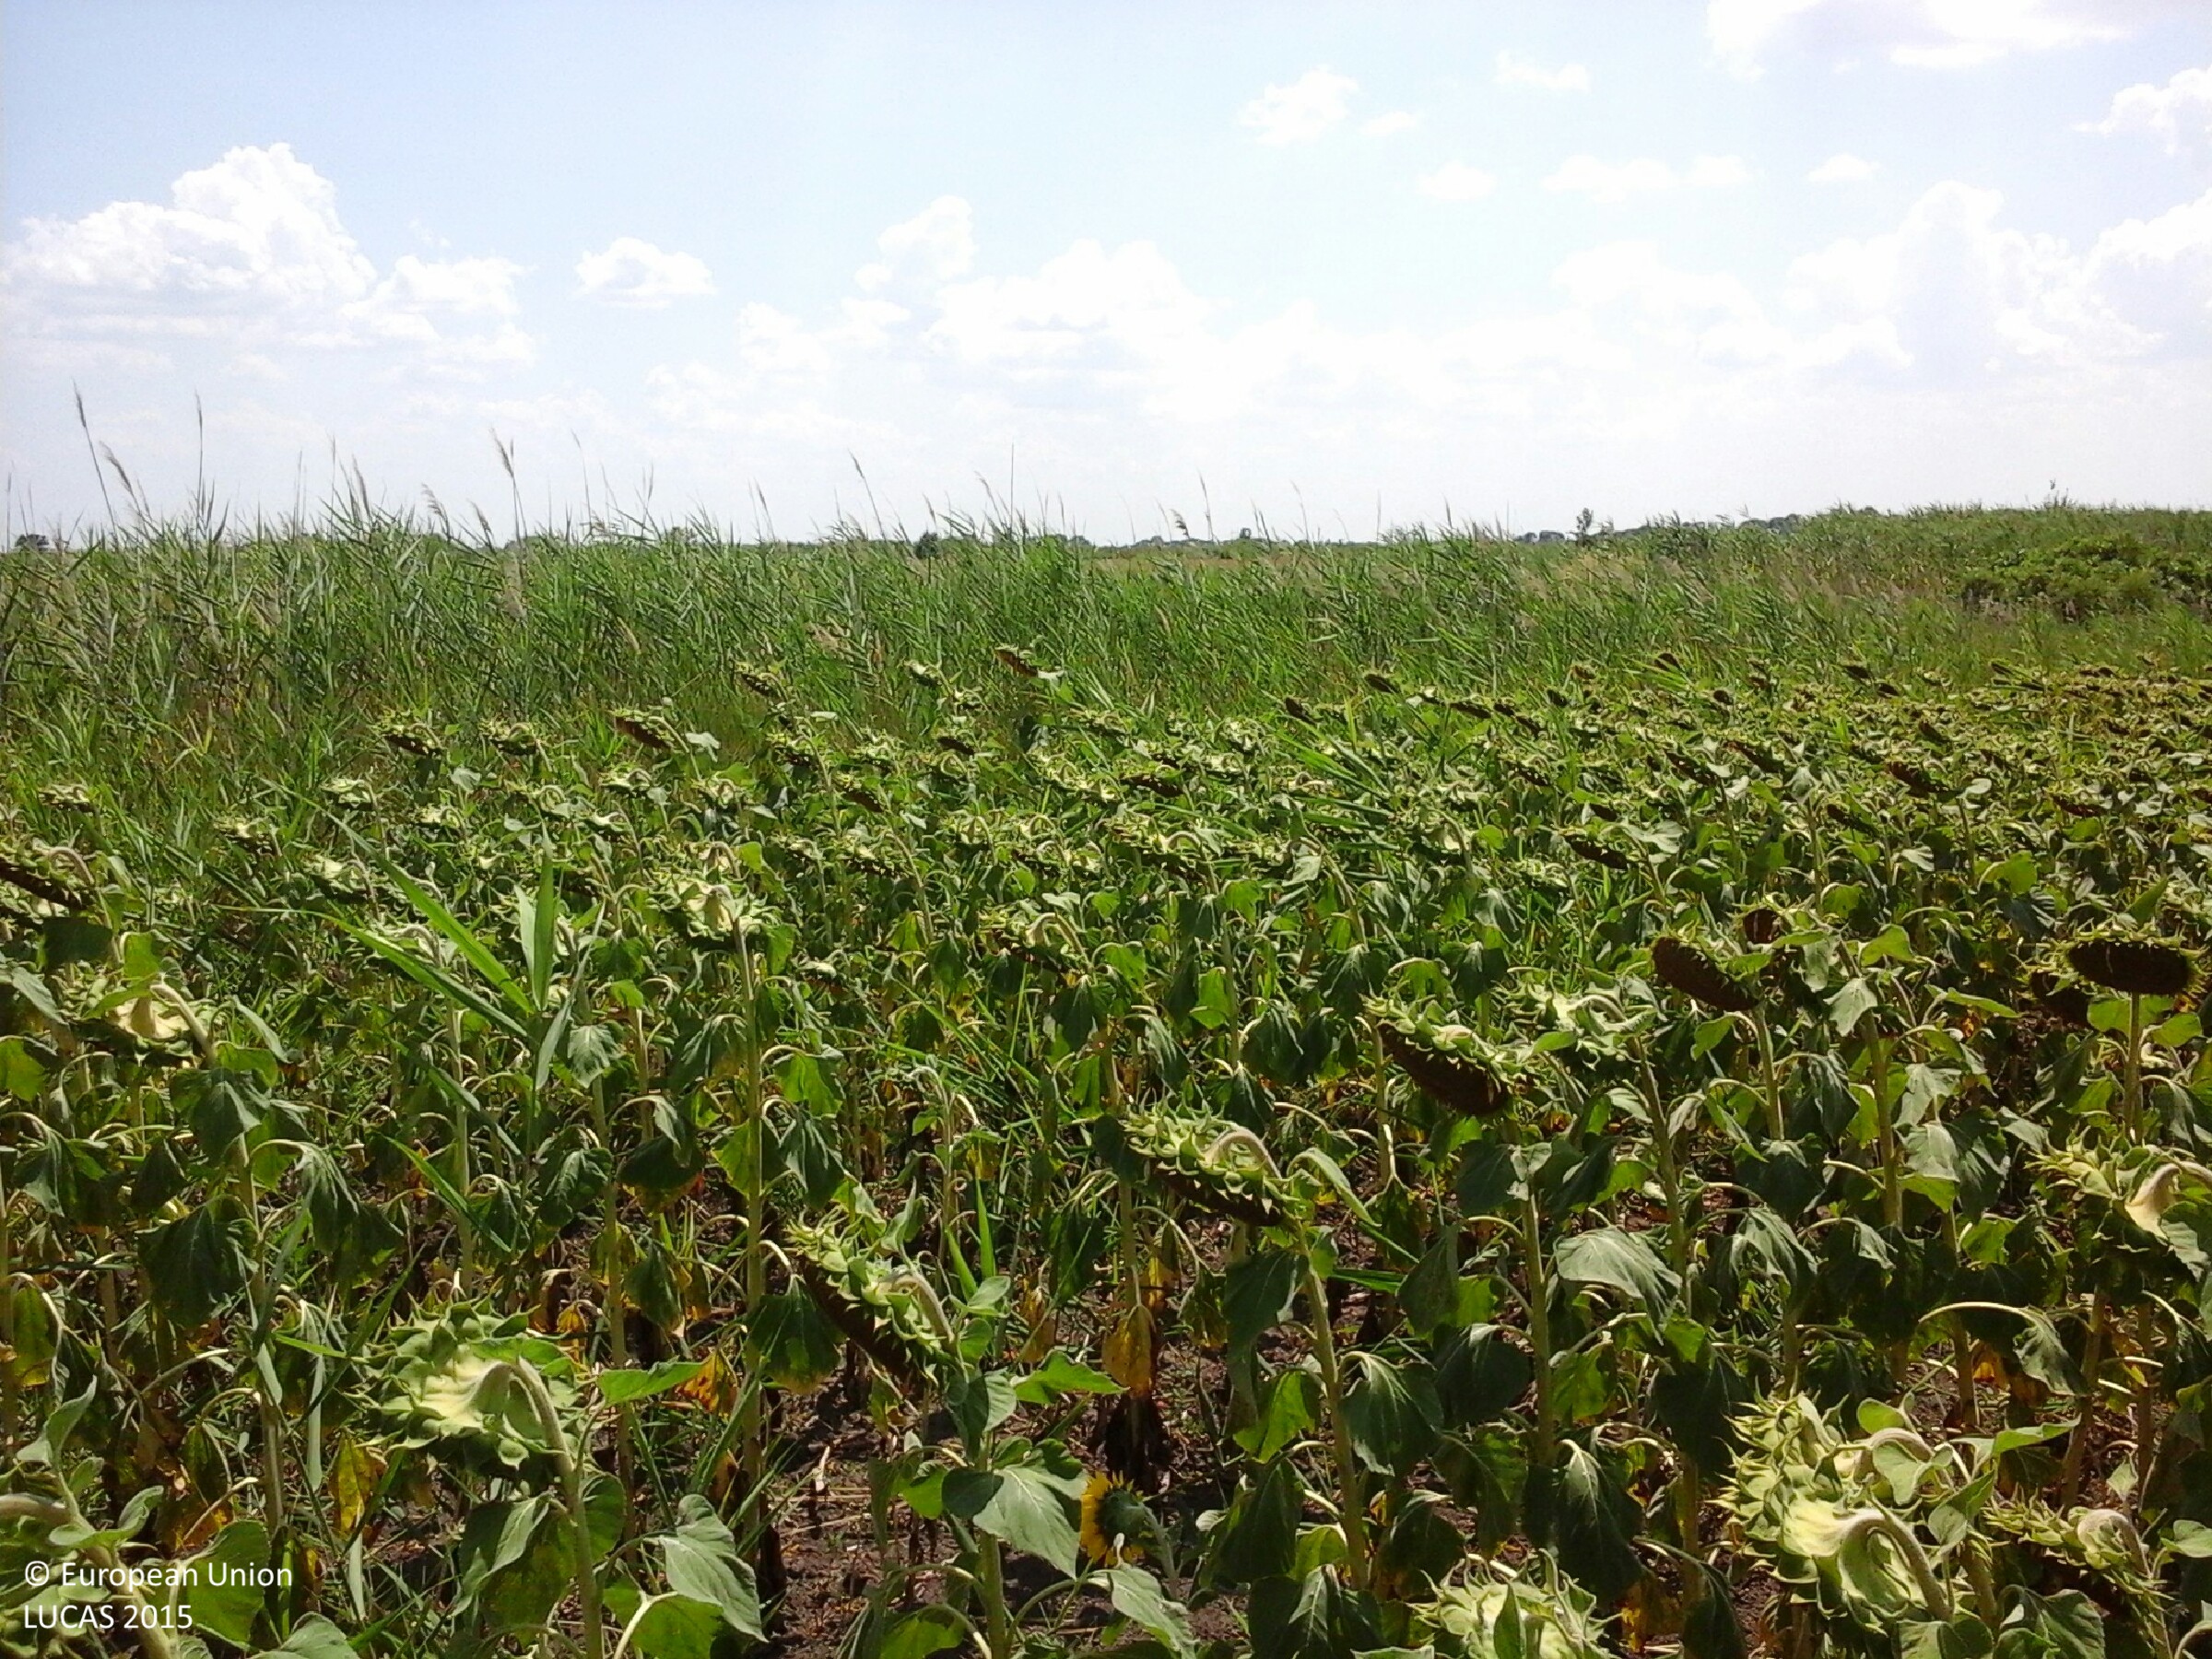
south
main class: Cropland
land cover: Sunflower
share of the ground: > 75 %
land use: Agriculture (excluding fallow land and kitchen gardens)
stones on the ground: < 10 %
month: July
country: HU
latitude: 47.7108
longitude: 20.6025
